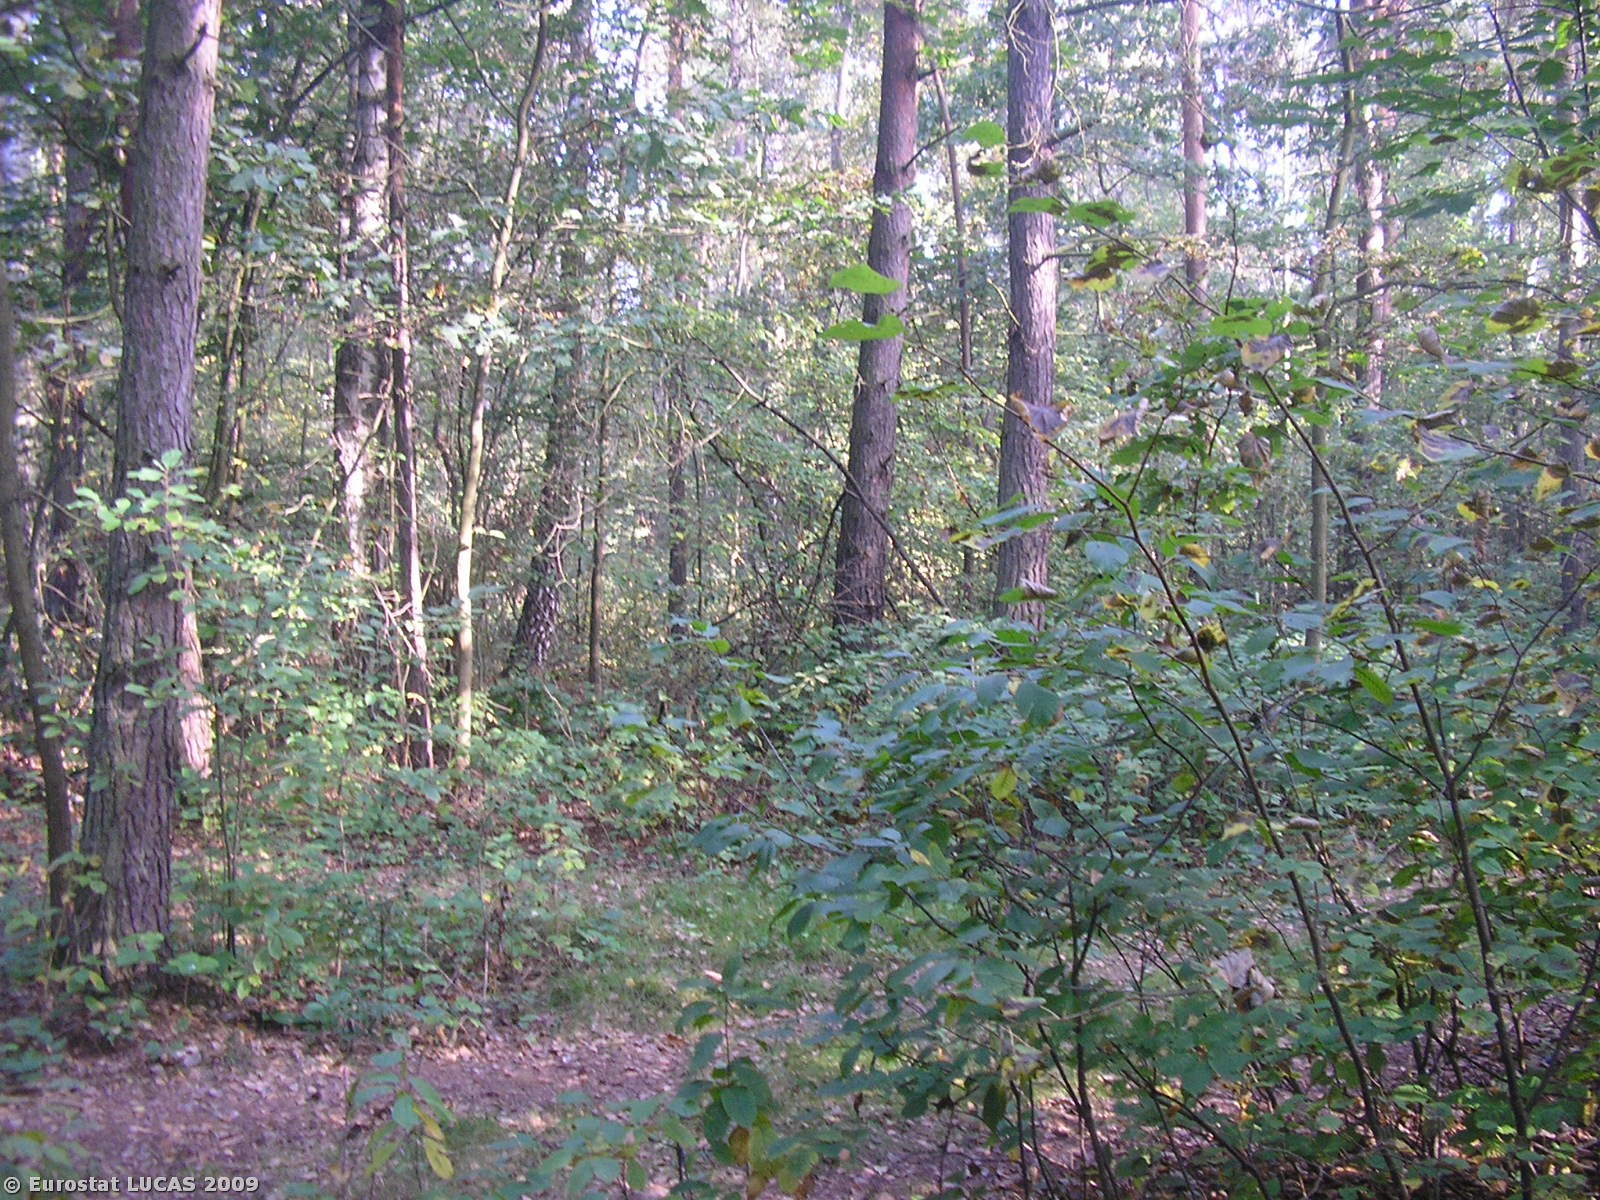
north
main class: Woodland
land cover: Mixed woodland
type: hemiboreal forest and nemoral coniferous forest and mixed broadleaved-coniferous forest
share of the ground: > 75 %
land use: Forestry
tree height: > 5 m
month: September
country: PL
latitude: 51.8701
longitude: 20.7452
